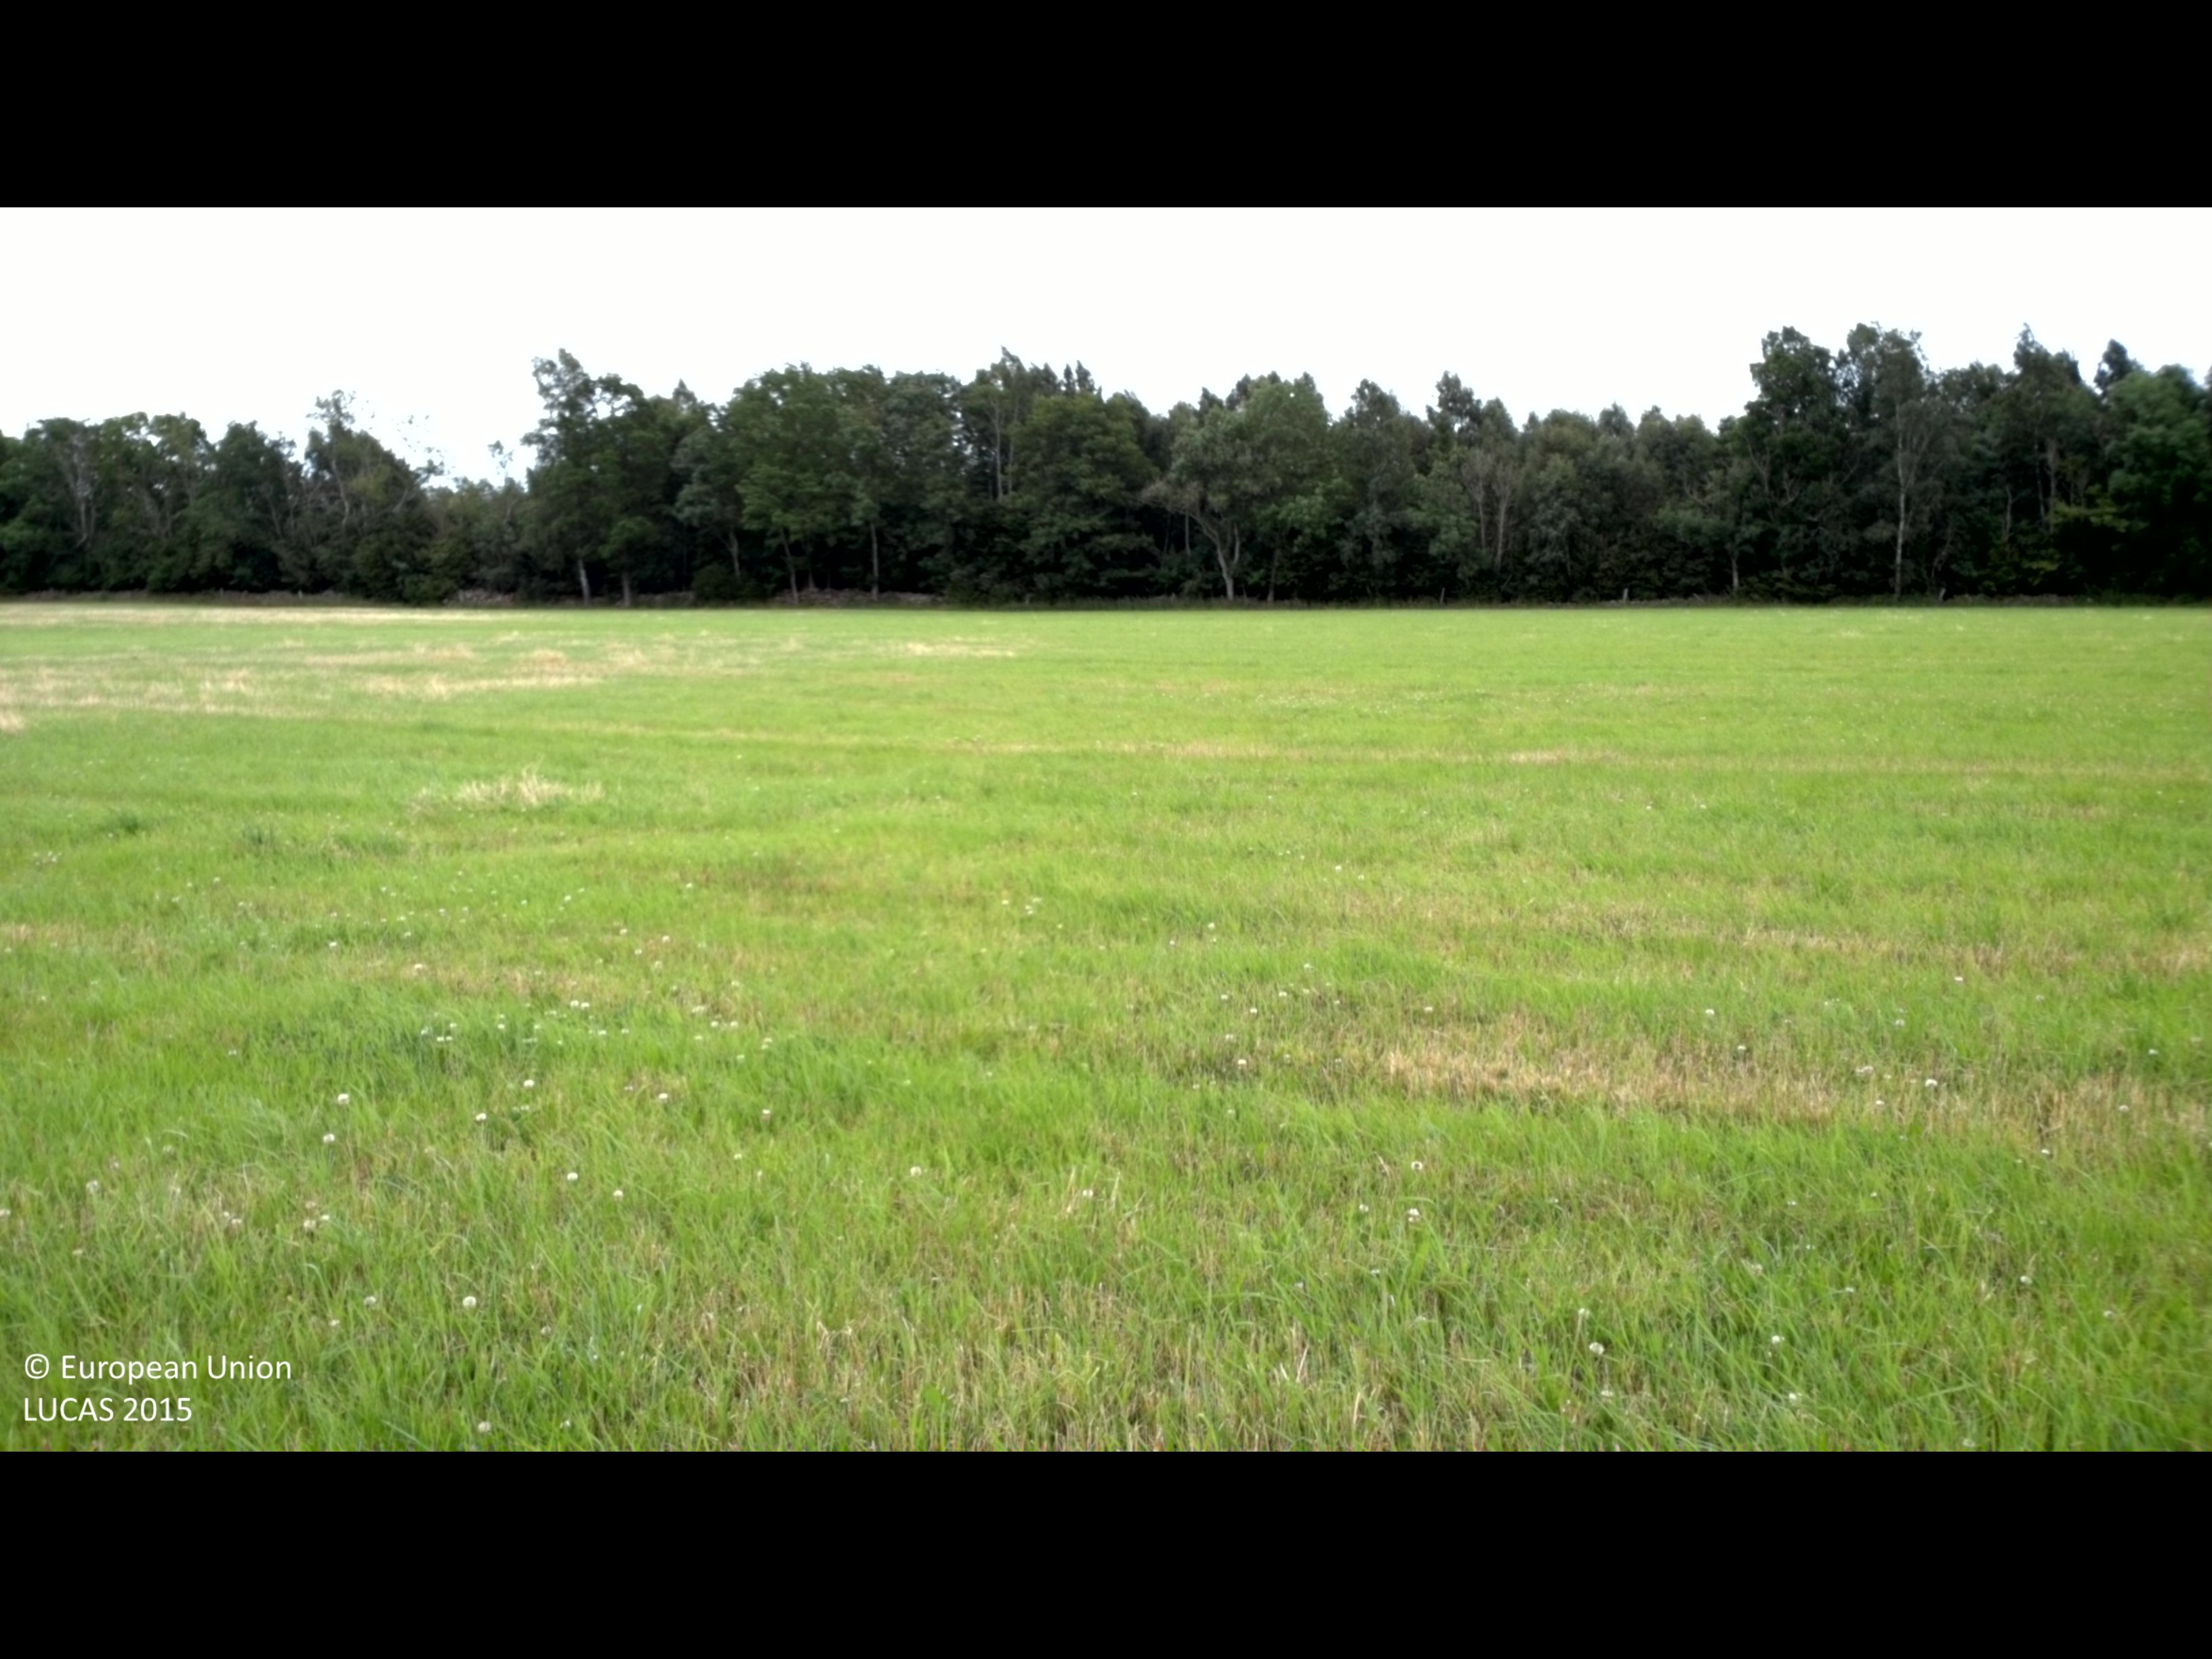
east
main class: Cropland
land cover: Other leguminous and mixtures for fodder
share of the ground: > 75 %
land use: Agriculture (excluding fallow land and kitchen gardens)
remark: Harvested field
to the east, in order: Other leguminous and mixtures for fodder; Fences; Dry stone walls; Broadleaved woodland; Ditches and canals; Broadleaved woodland; Ditches and canals; Broadleaved woodland
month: July
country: SE
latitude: 56.7061
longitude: 16.5514
